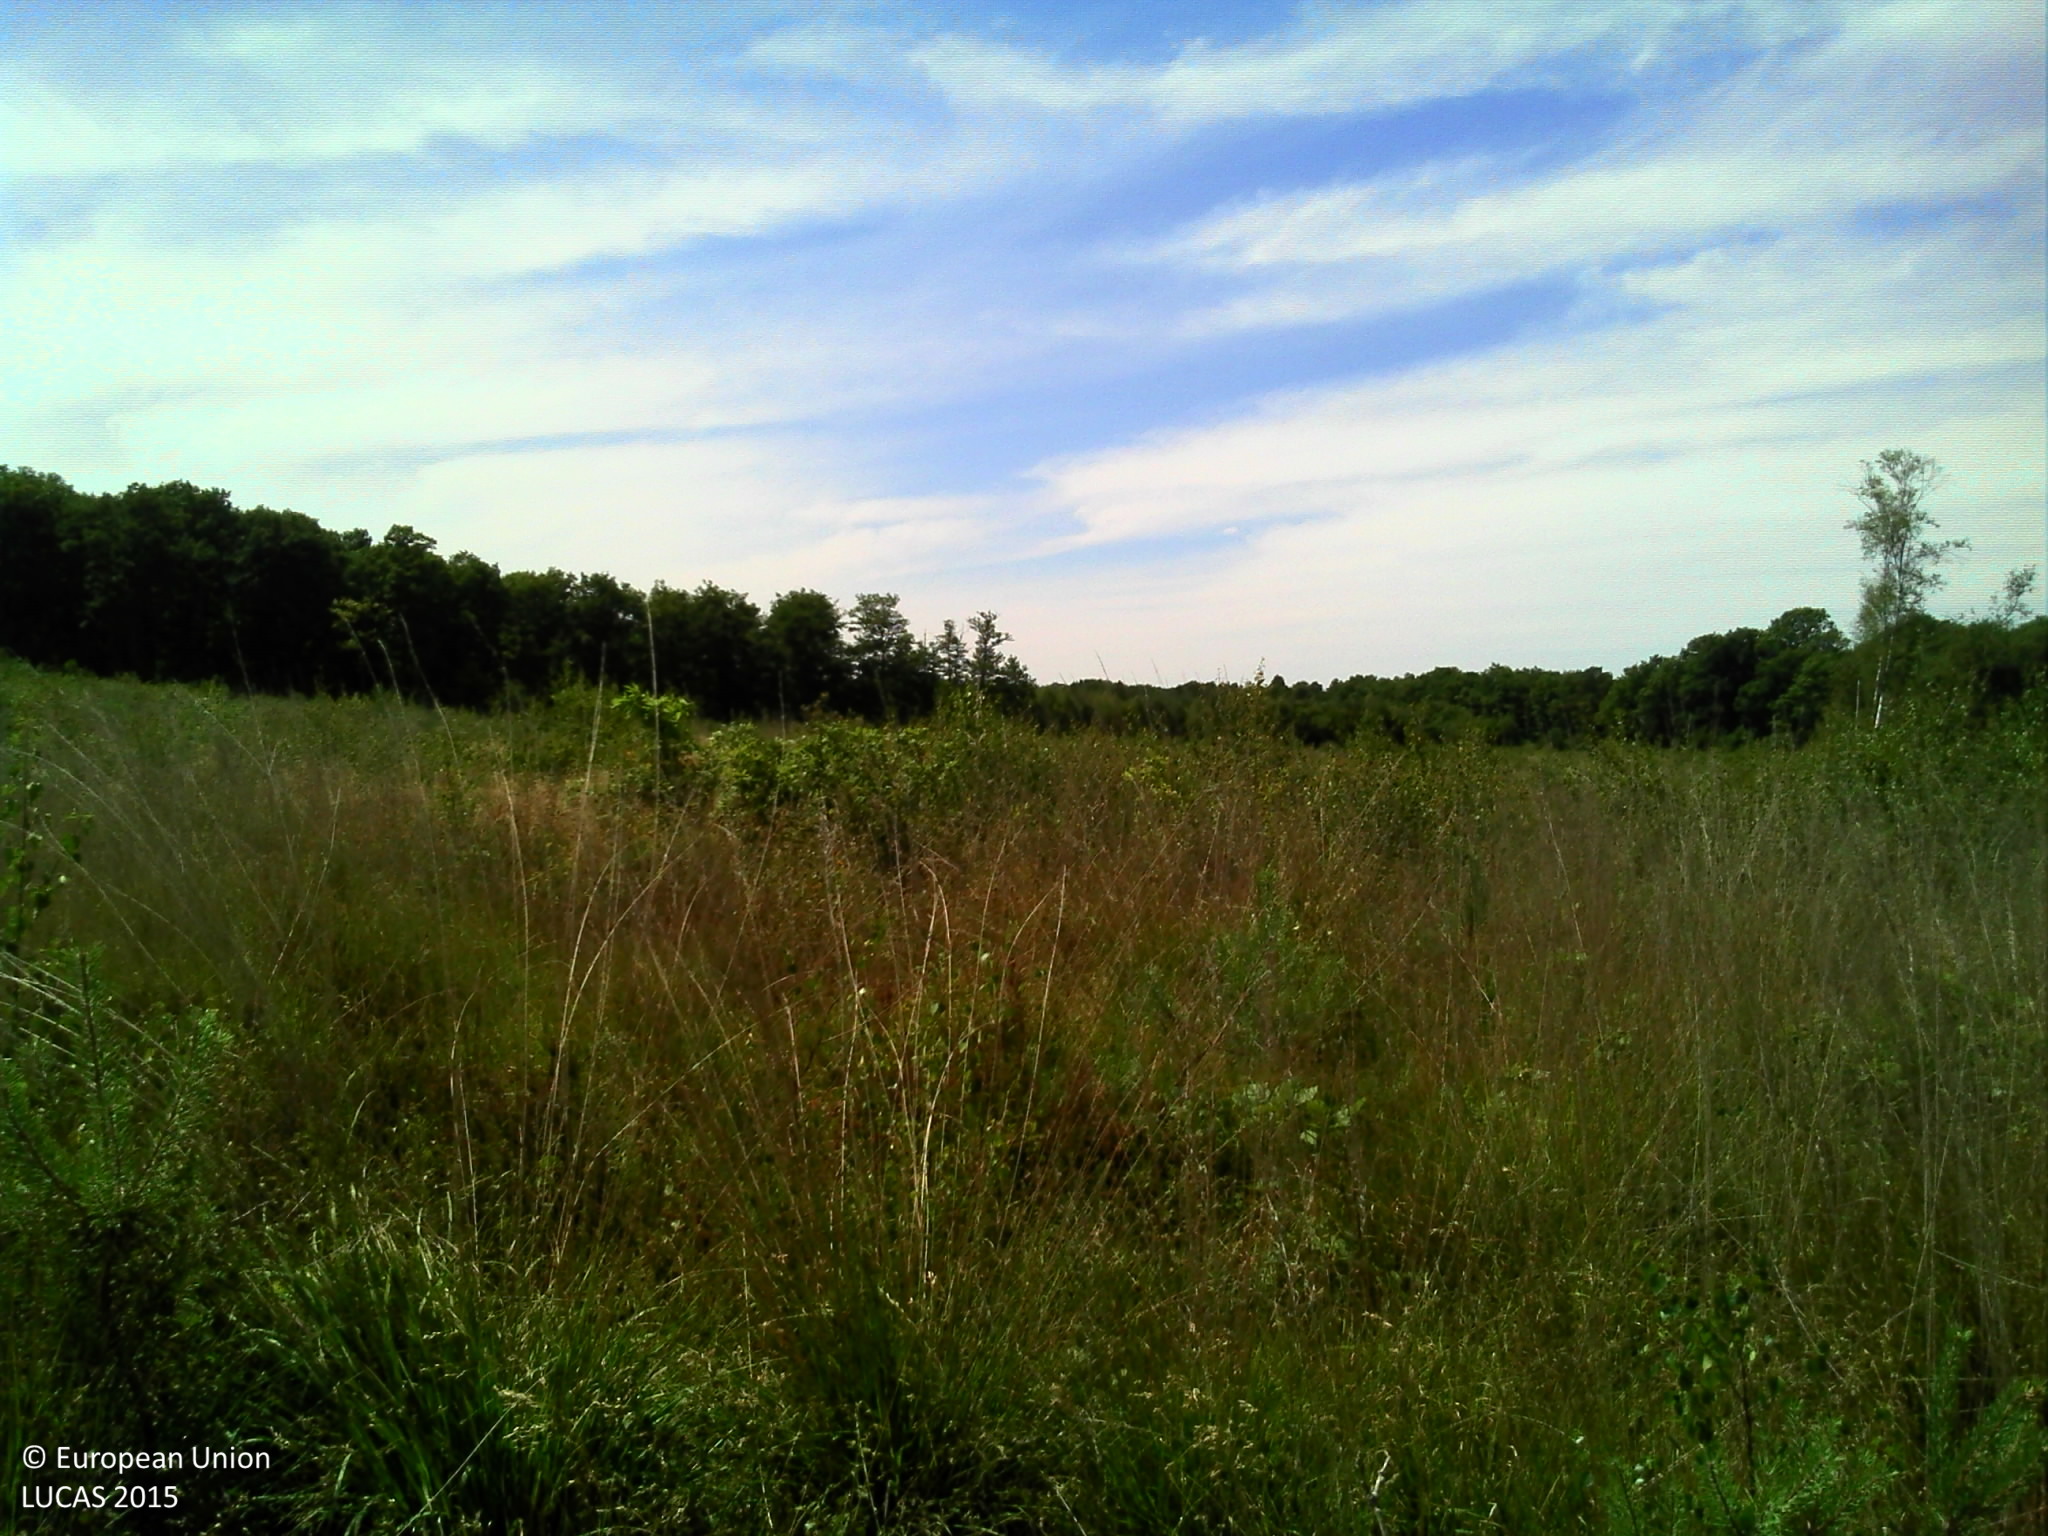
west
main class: Shrubland
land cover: Shrubland with sparse tree cover
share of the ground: > 75 %
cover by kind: herbaceous plants 85 %, shrubs 10 %, broadleaved forest trees 5 %
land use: Forestry
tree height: < 5 m
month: July
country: FR
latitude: 47.9482
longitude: 1.9675
